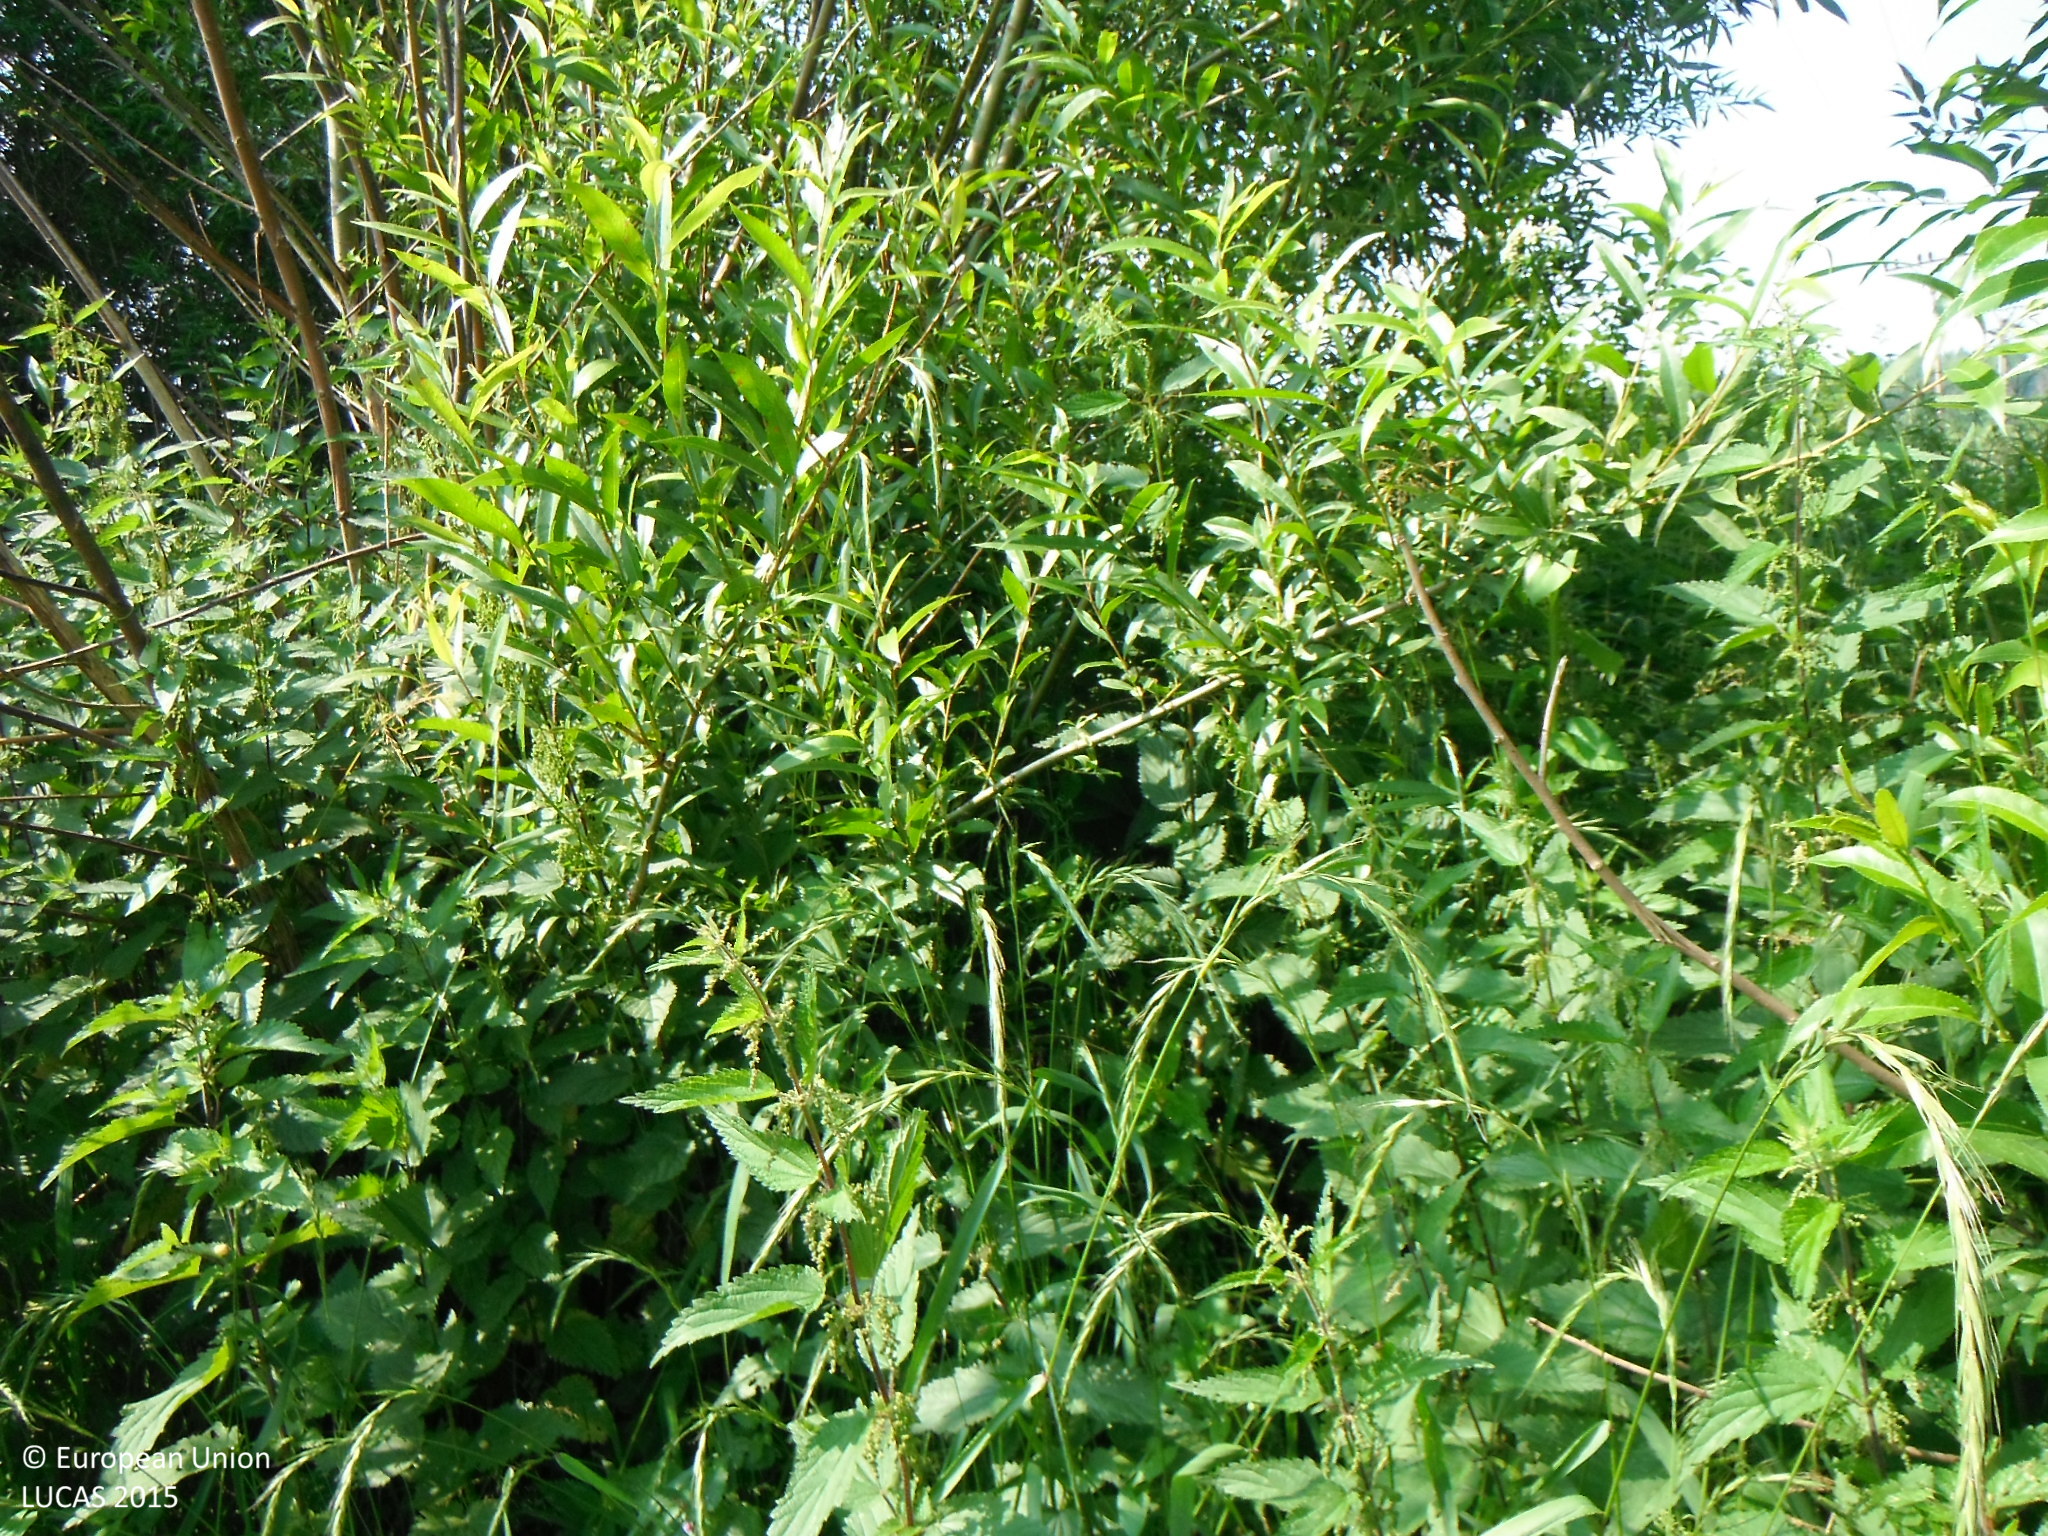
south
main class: Grassland
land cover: Spontaneously vegetated surfaces
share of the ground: > 75 %
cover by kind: herbaceous plants 100 %
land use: Semi-natural and natural areas not in use
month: July
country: SK
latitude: 49.1242
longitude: 19.4119
